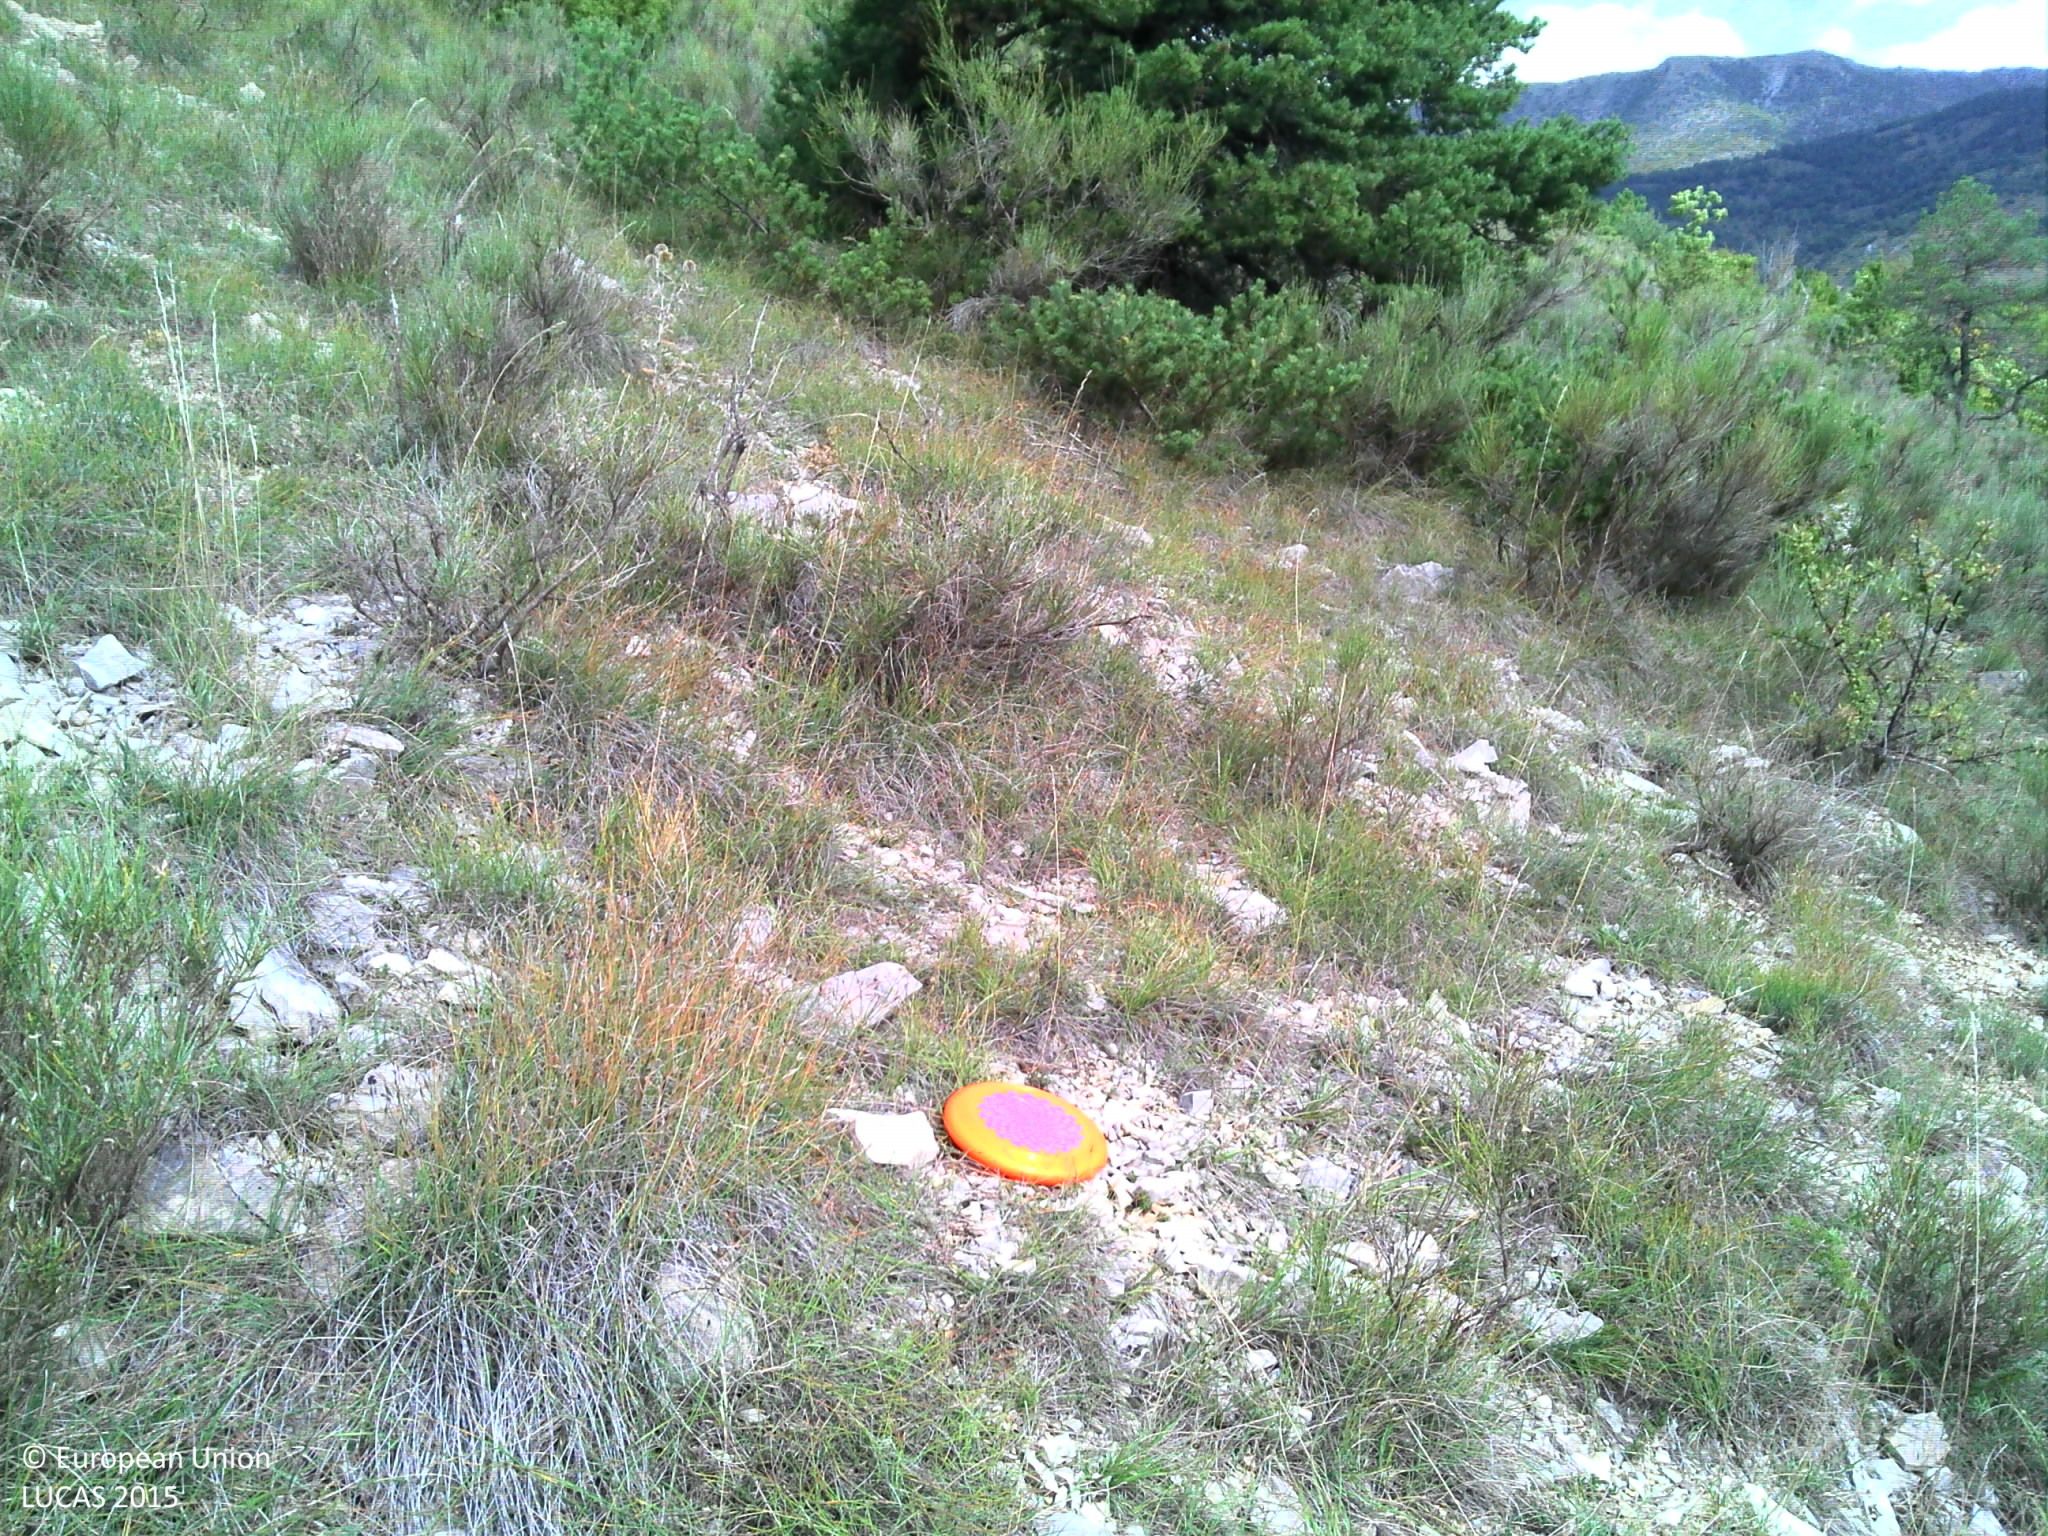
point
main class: Shrubland
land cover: Shrubland with sparse tree cover
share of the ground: 25 - 50 %
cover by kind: shrubs 55 %, herbaceous plants 20 %, consolidated bare surface 20 %, broadleaved forest trees 5 %
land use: Semi-natural and natural areas not in use
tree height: > 5 m
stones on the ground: 10 - 25 %
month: September
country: FR
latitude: 44.3975
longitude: 5.5000
